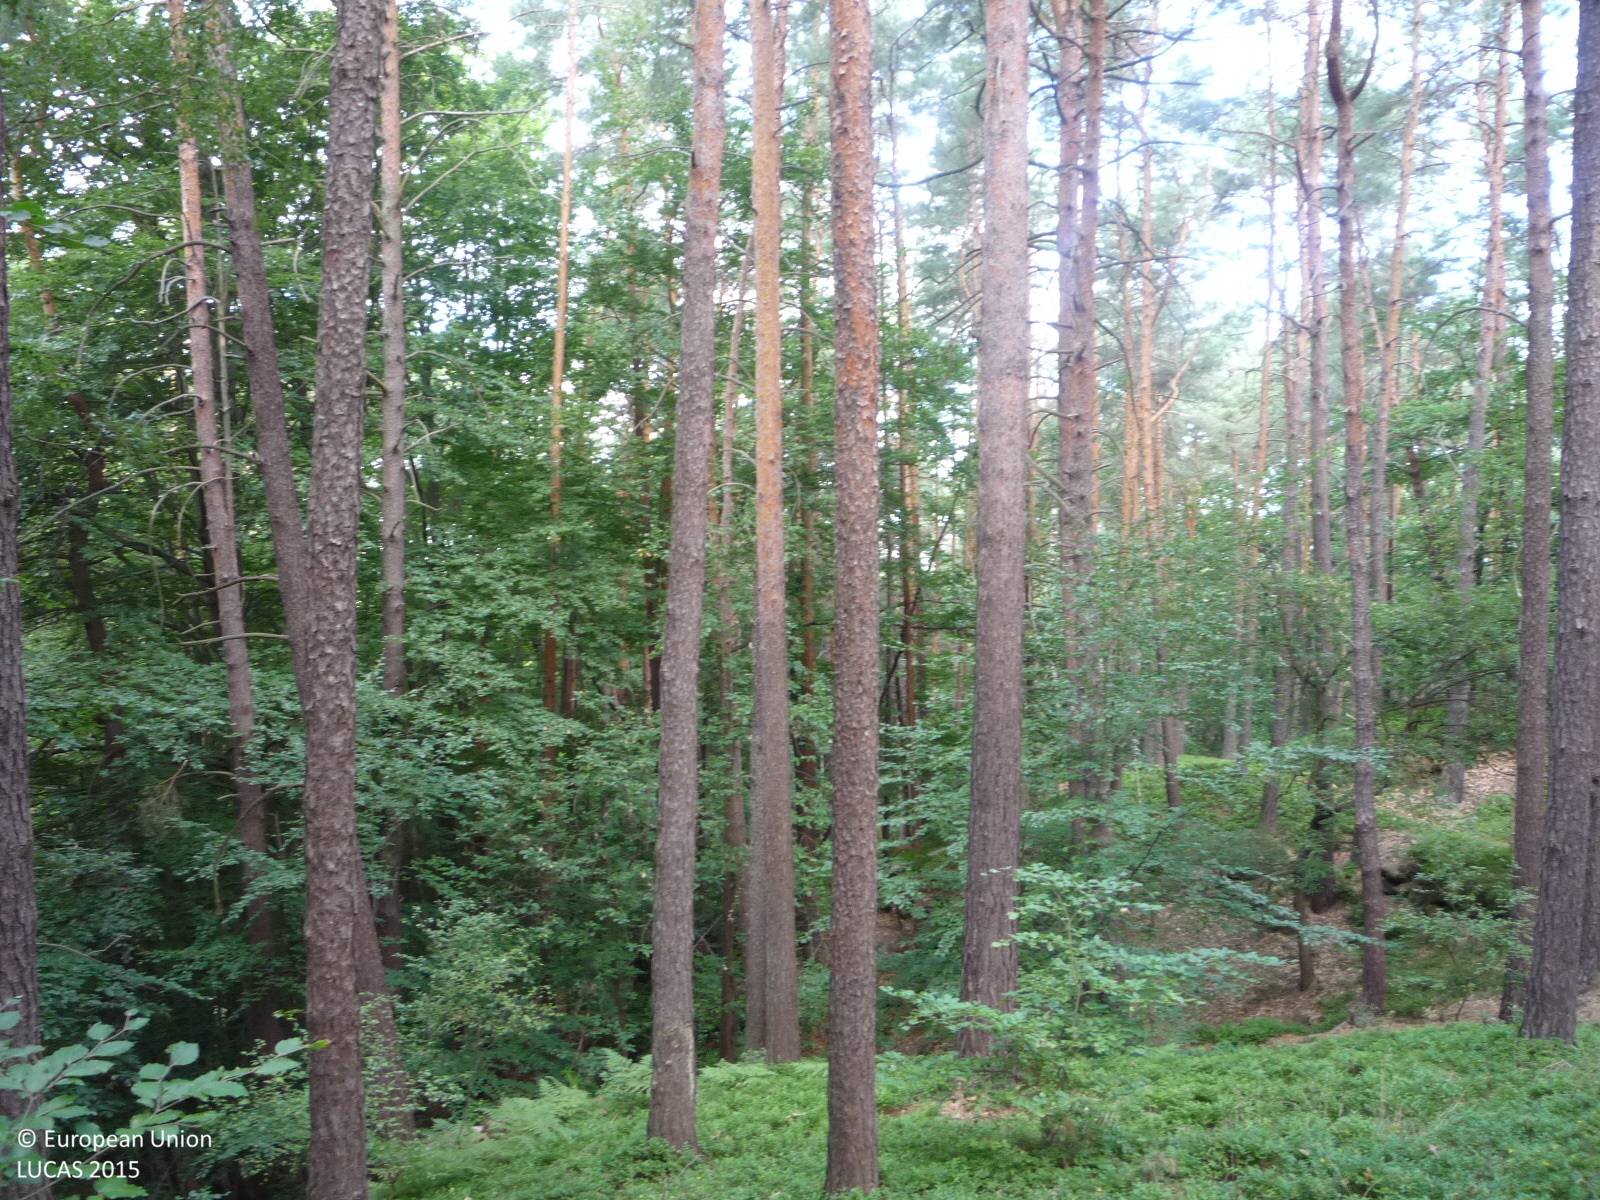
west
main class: Woodland
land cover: Pine dominated mixed woodland
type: hemiboreal forest and nemoral coniferous forest and mixed broadleaved-coniferous forest
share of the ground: > 75 %
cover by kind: coniferous forest trees 60 %, broadleaved forest trees 35 %, herbaceous plants 5 %
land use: Forestry
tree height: > 5 m
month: July
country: CZ
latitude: 50.5086
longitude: 14.5282
